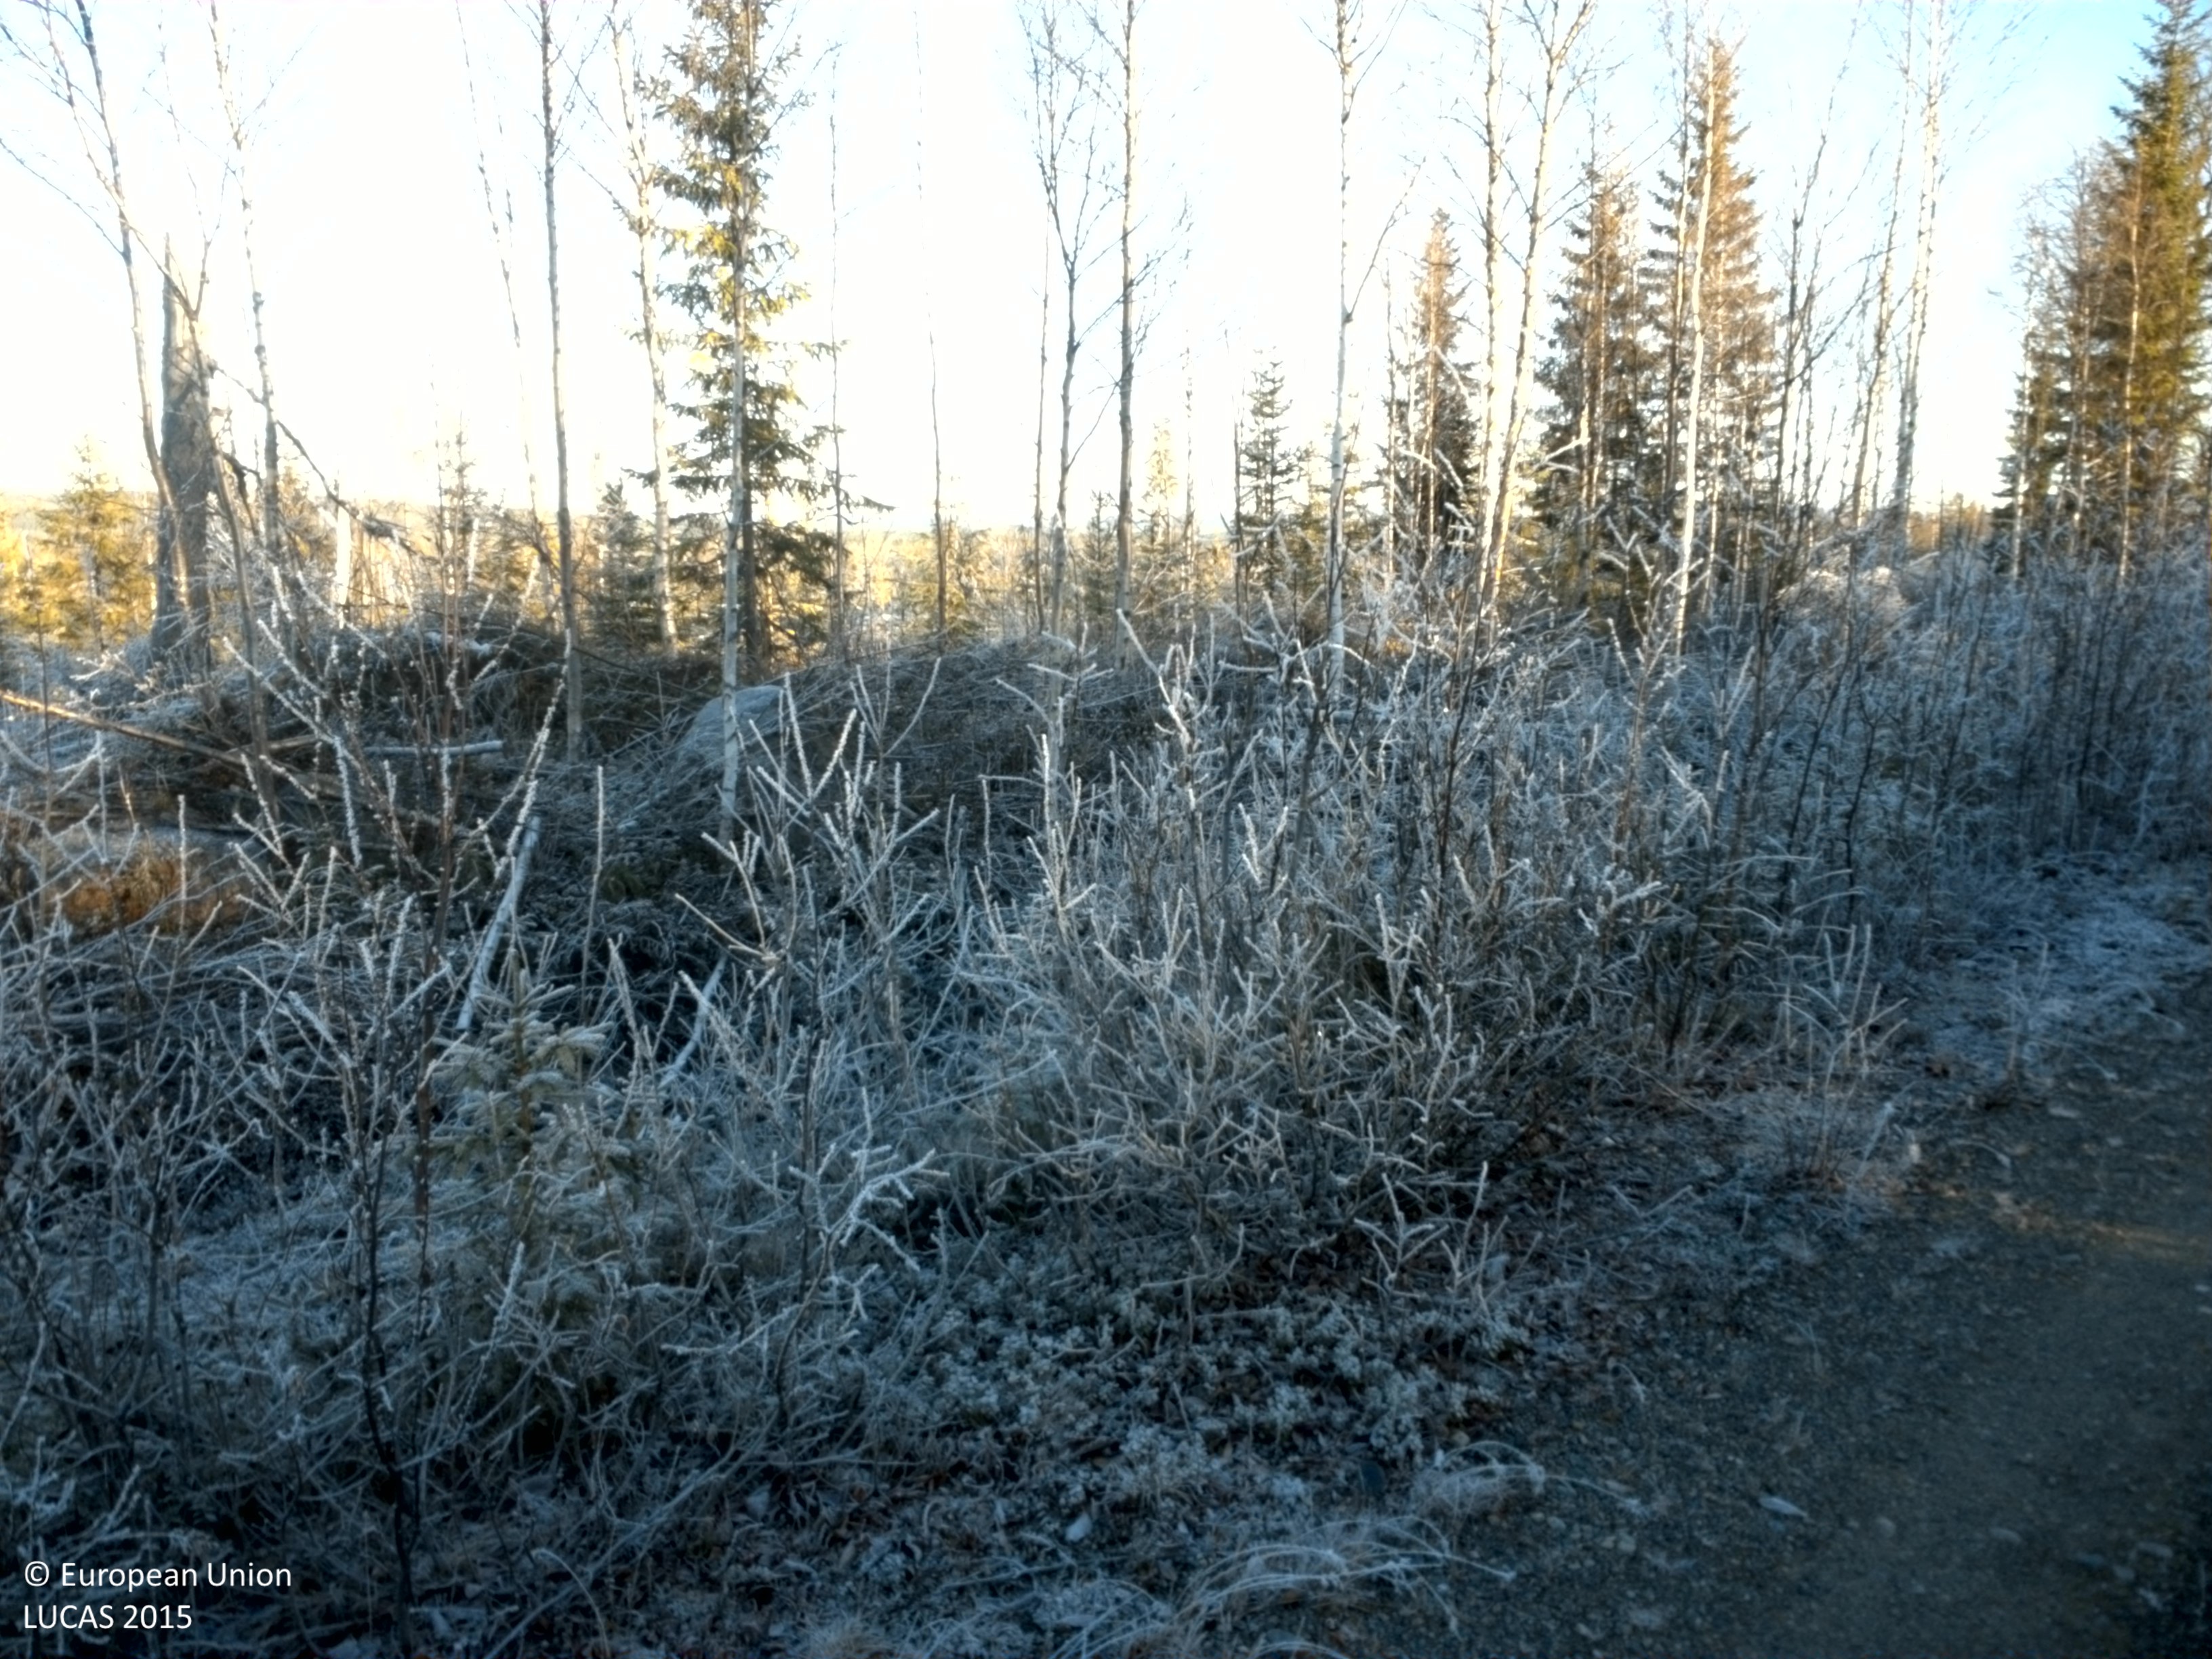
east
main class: Artificial land
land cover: Non built-up linear features
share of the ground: > 75 %
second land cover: Grassland without tree/shrub cover
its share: 10 - 25 %
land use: Road transport
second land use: Forestry
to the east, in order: Paved roads, cycling and walking lanes; Broadleaved woodland; Spruce dominated mixed woodland; Spruce dominated coniferous woodland; Spruce dominated mixed woodland
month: October
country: SE
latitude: 64.4406
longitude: 16.6363
